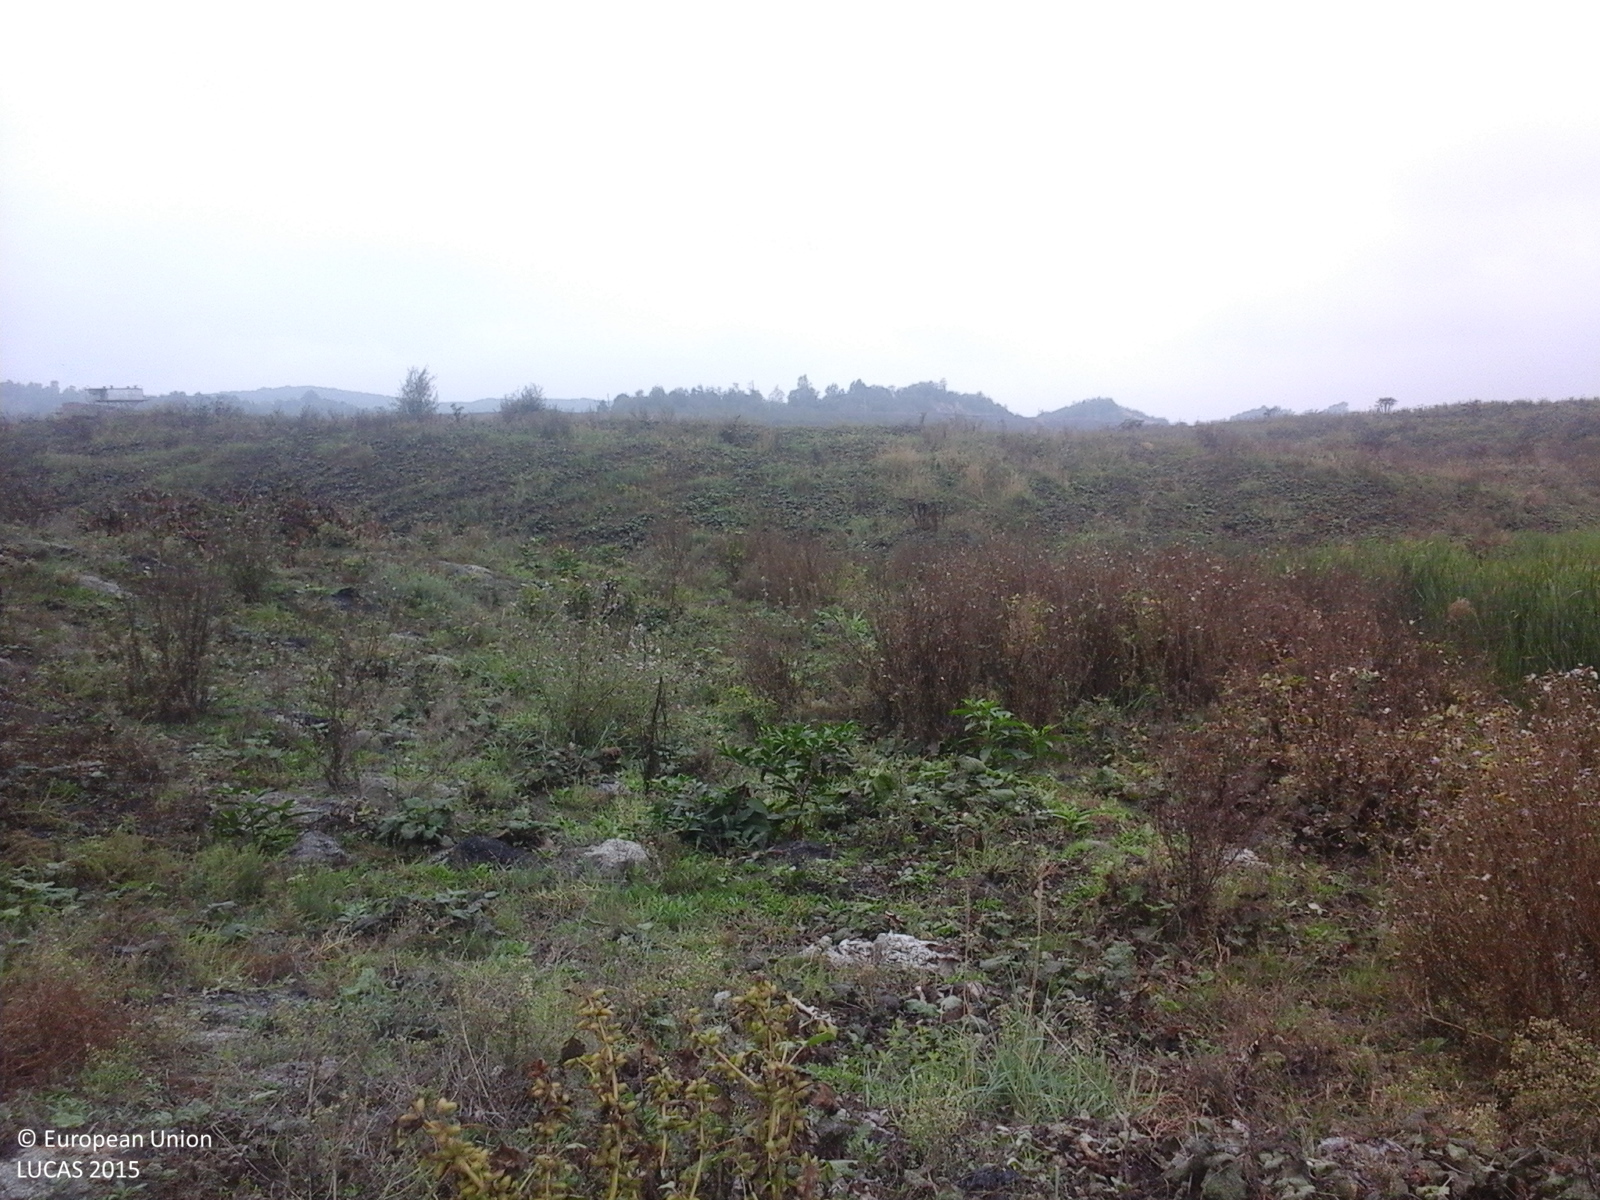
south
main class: Grassland
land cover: Spontaneously vegetated surfaces
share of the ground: > 75 %
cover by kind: herbaceous plants 100 %
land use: Mining and quarrying
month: September
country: RO
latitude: 44.9198
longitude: 23.1113
